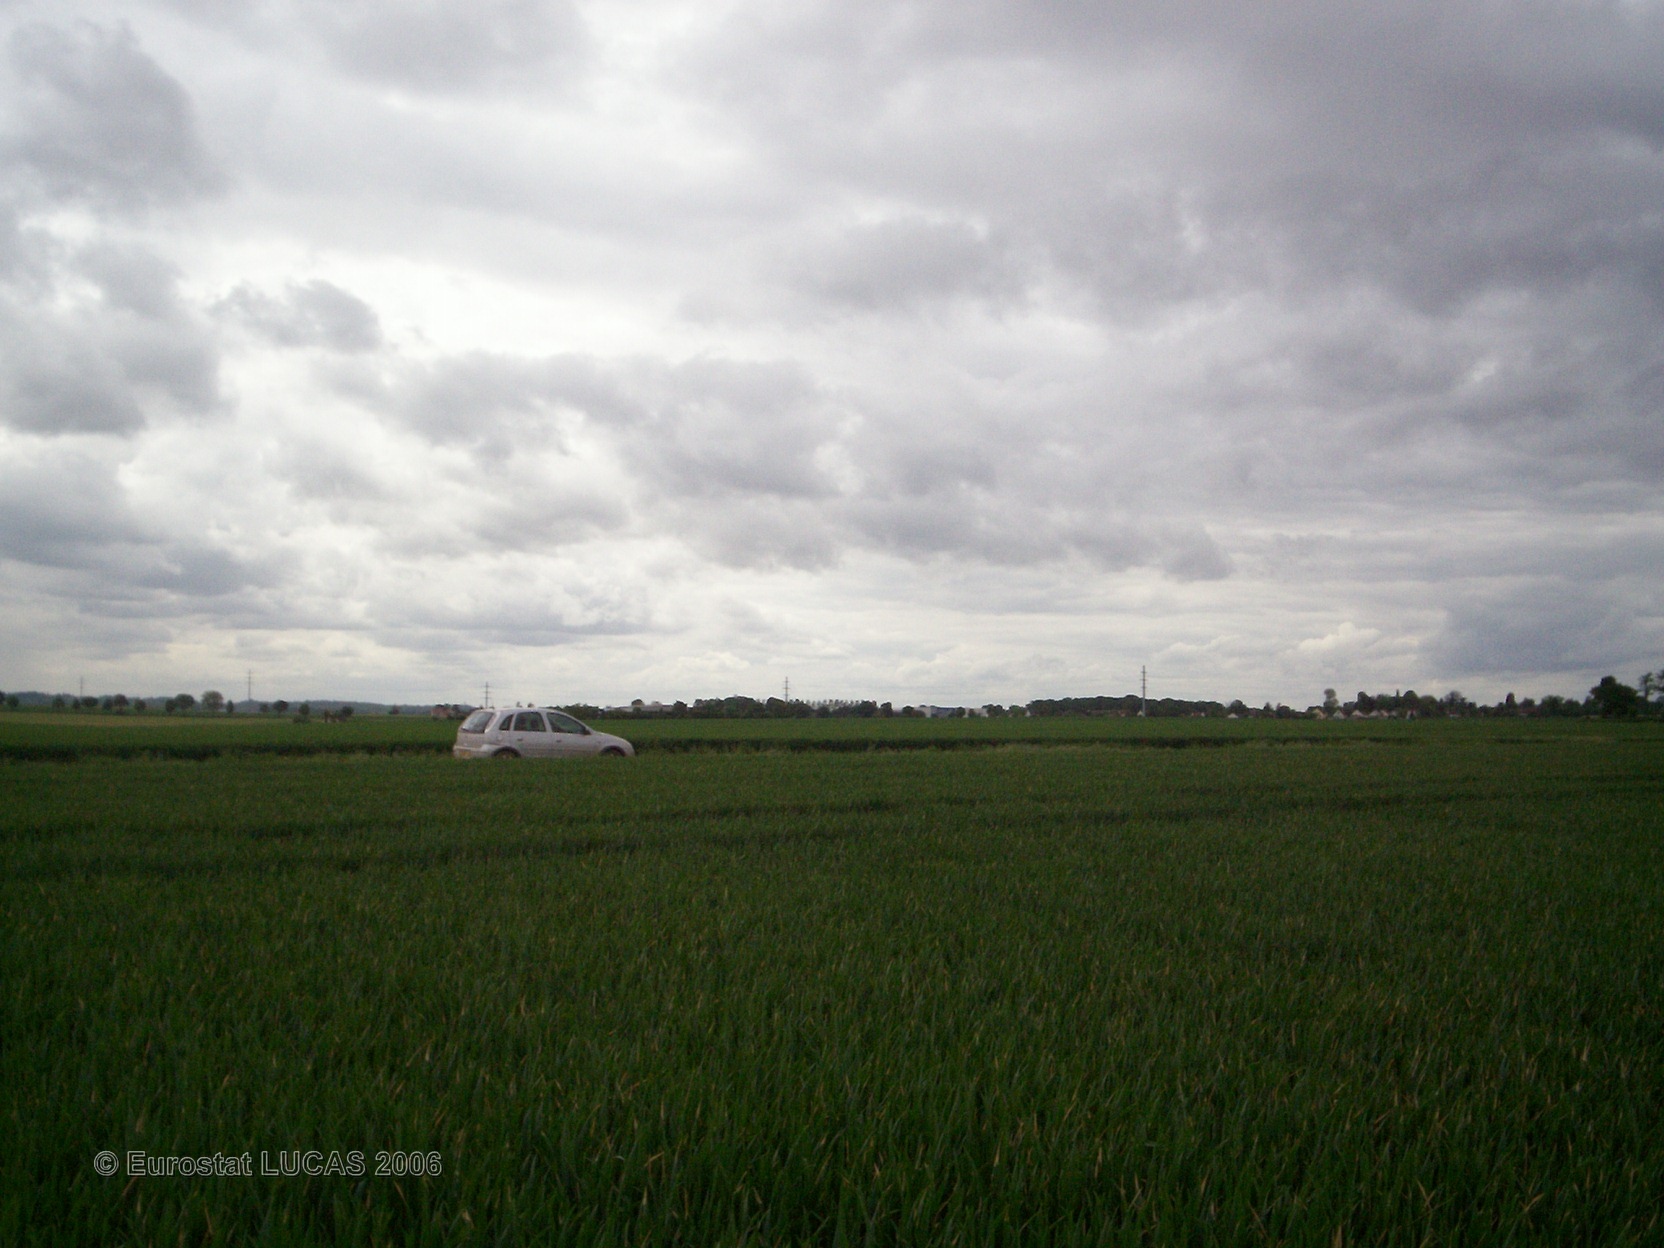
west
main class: Cropland
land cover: Common wheat
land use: Agriculture (excluding fallow land and kitchen gardens)
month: May
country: FR
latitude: 49.0881
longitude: 2.7736
